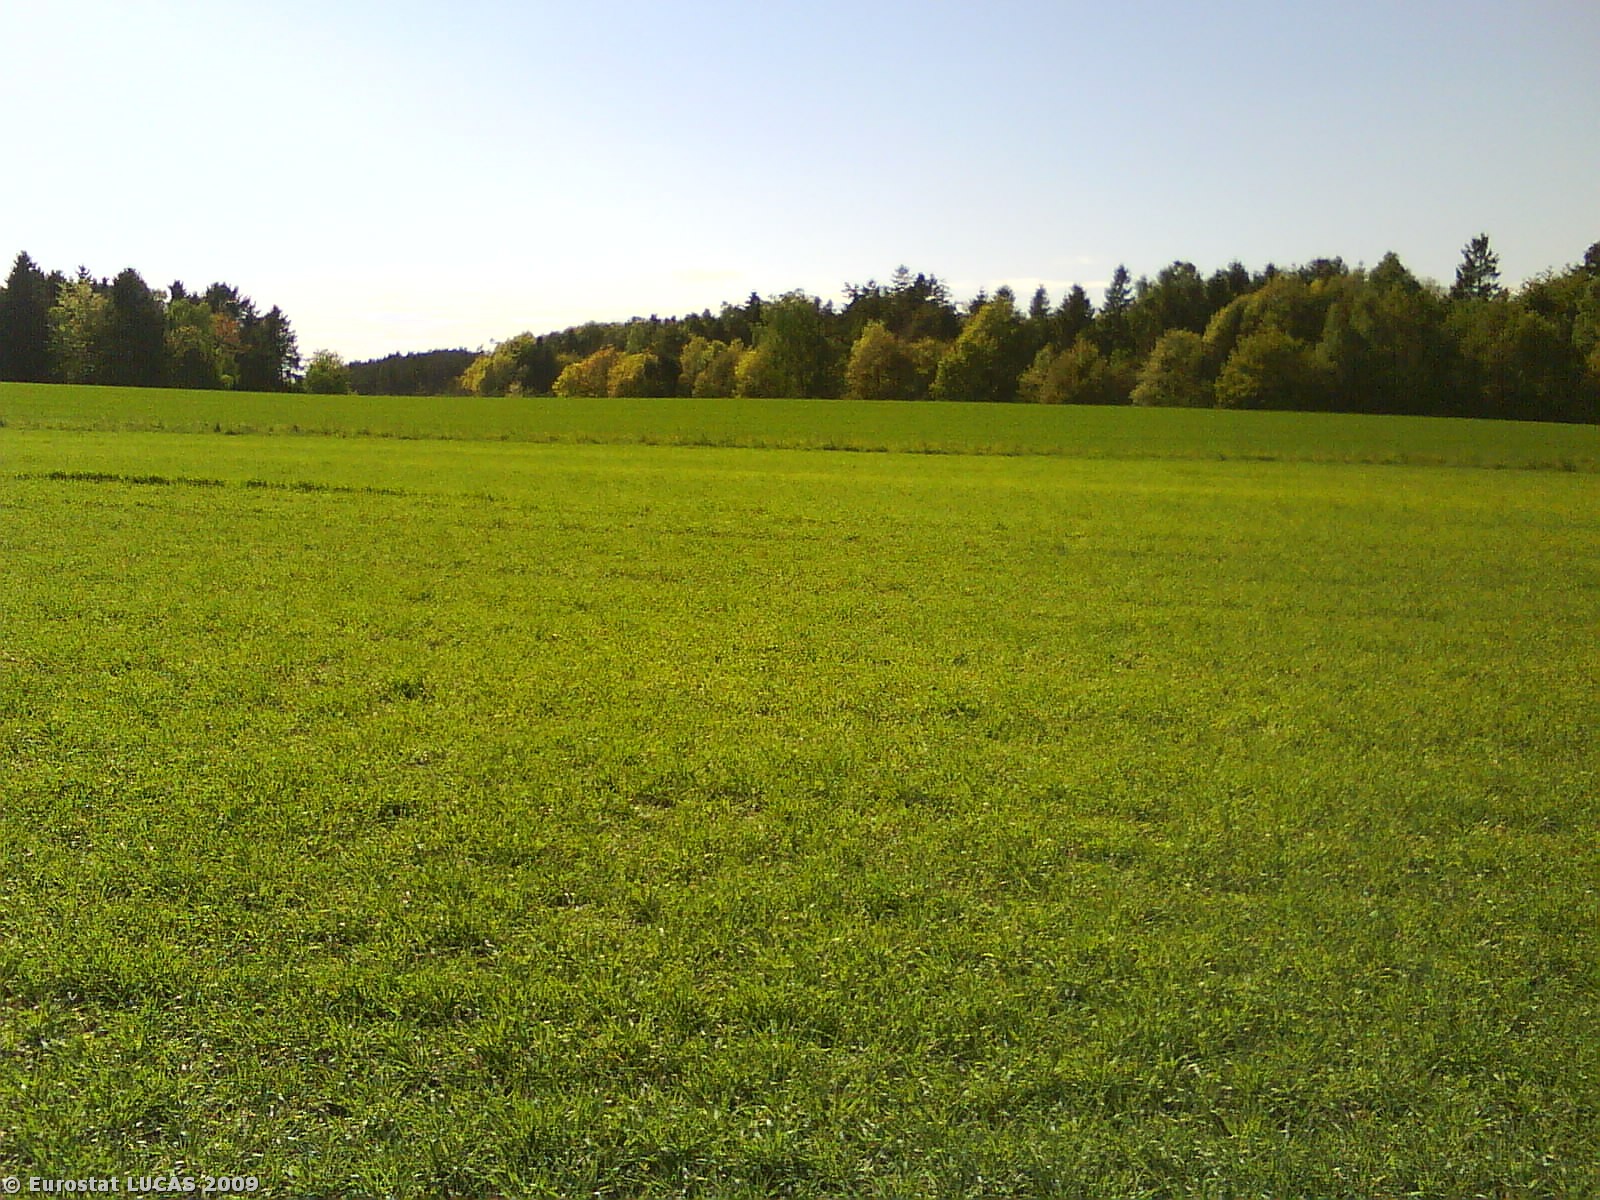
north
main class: Cropland
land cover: Barley
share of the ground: > 75 %
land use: Agriculture (excluding fallow land and kitchen gardens)
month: May
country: DK
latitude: 56.4373
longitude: 10.7289
